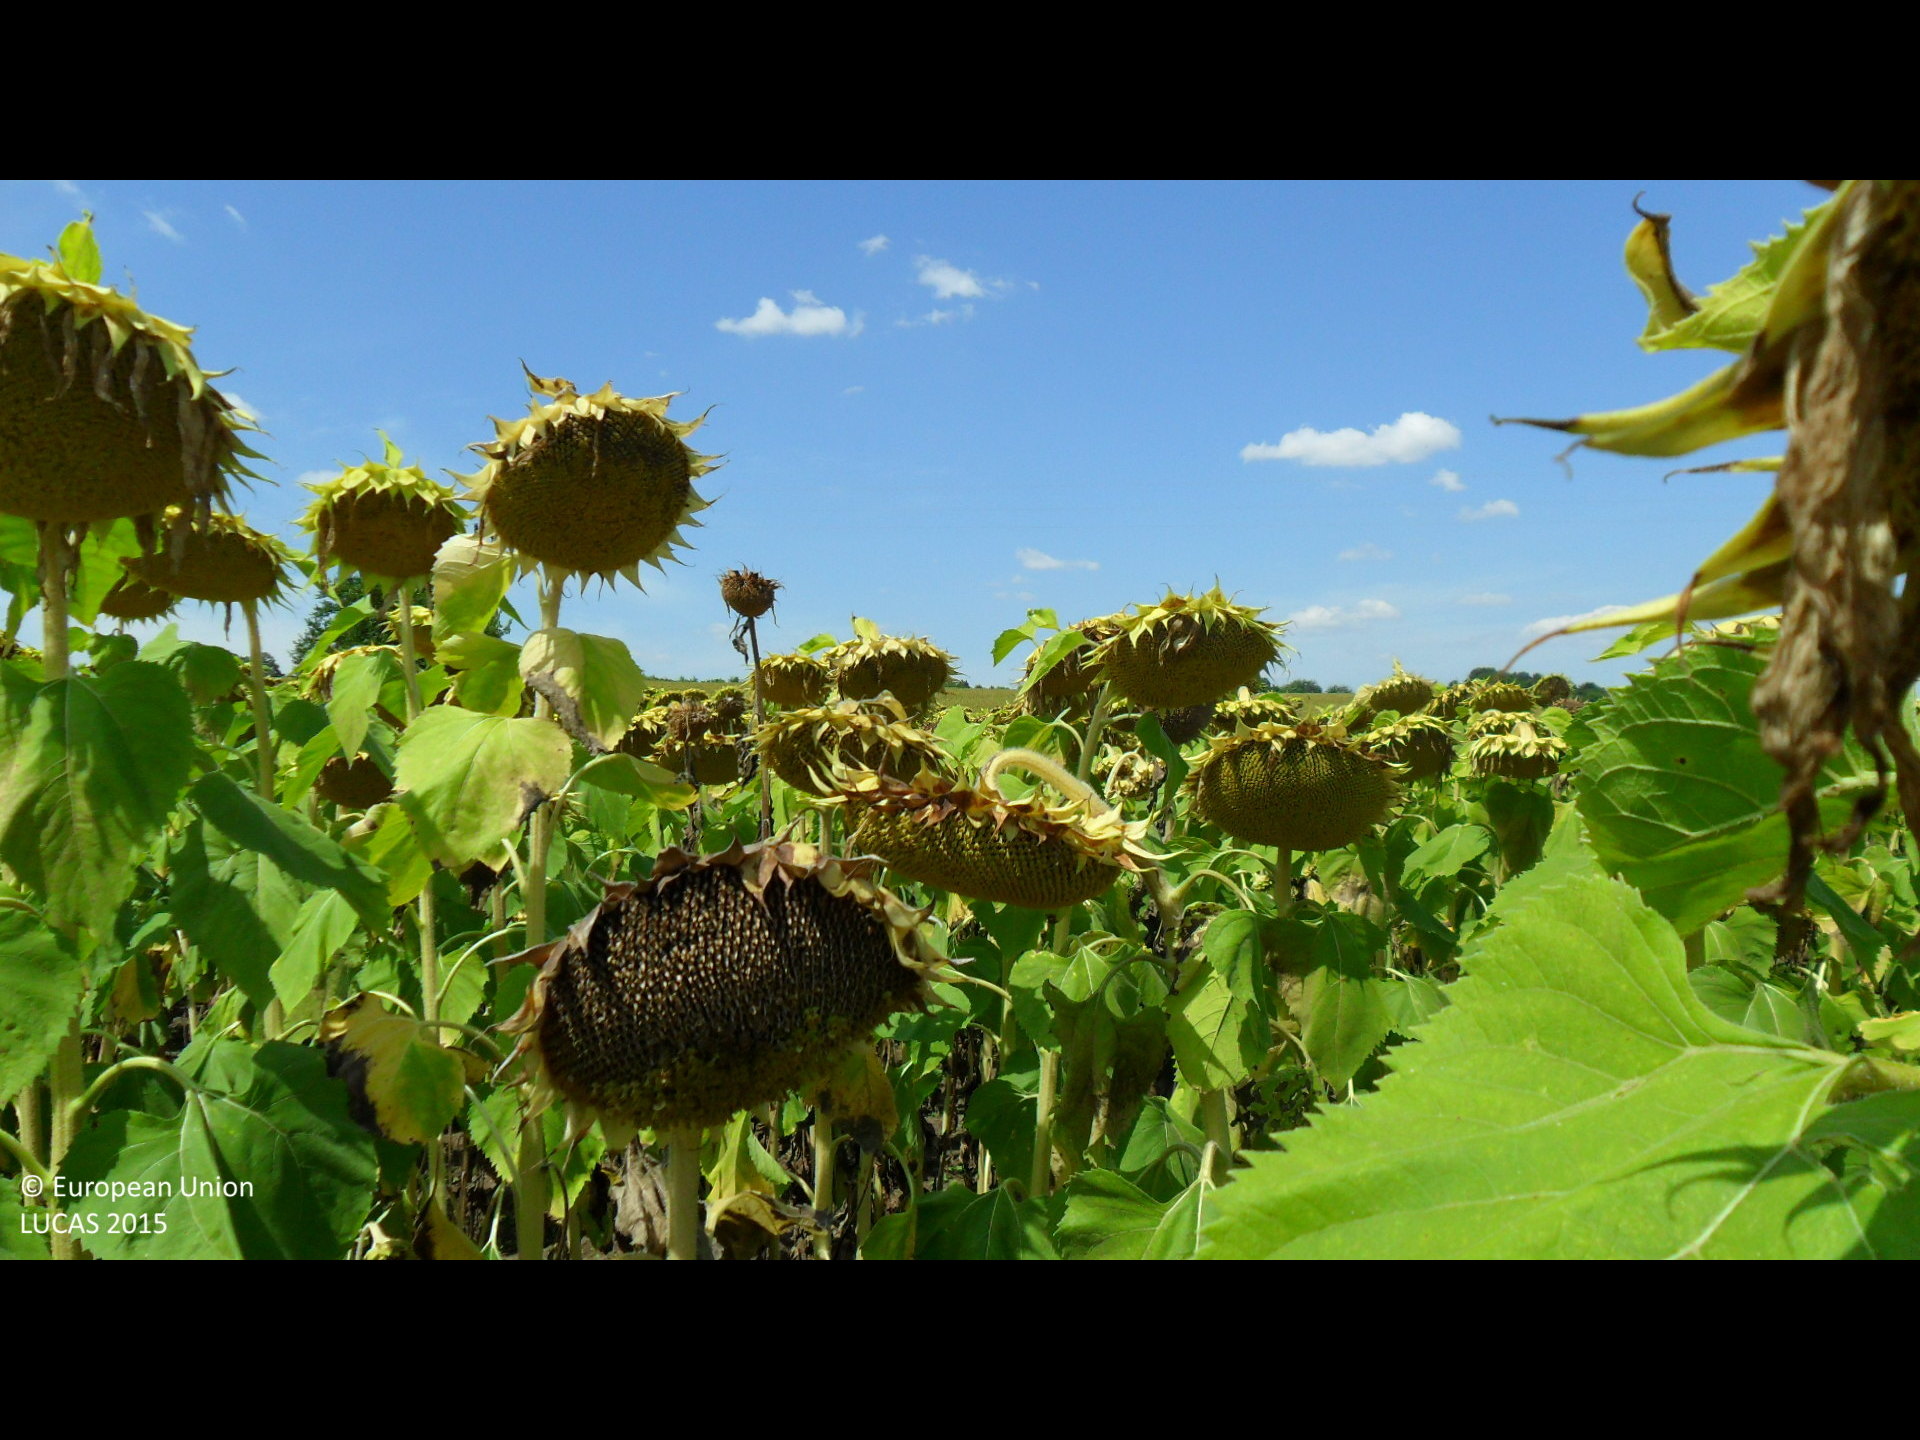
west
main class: Cropland
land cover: Sunflower
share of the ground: > 75 %
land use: Agriculture (excluding fallow land and kitchen gardens)
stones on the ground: < 10 %
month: August
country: BG
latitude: 43.3751
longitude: 26.4553
